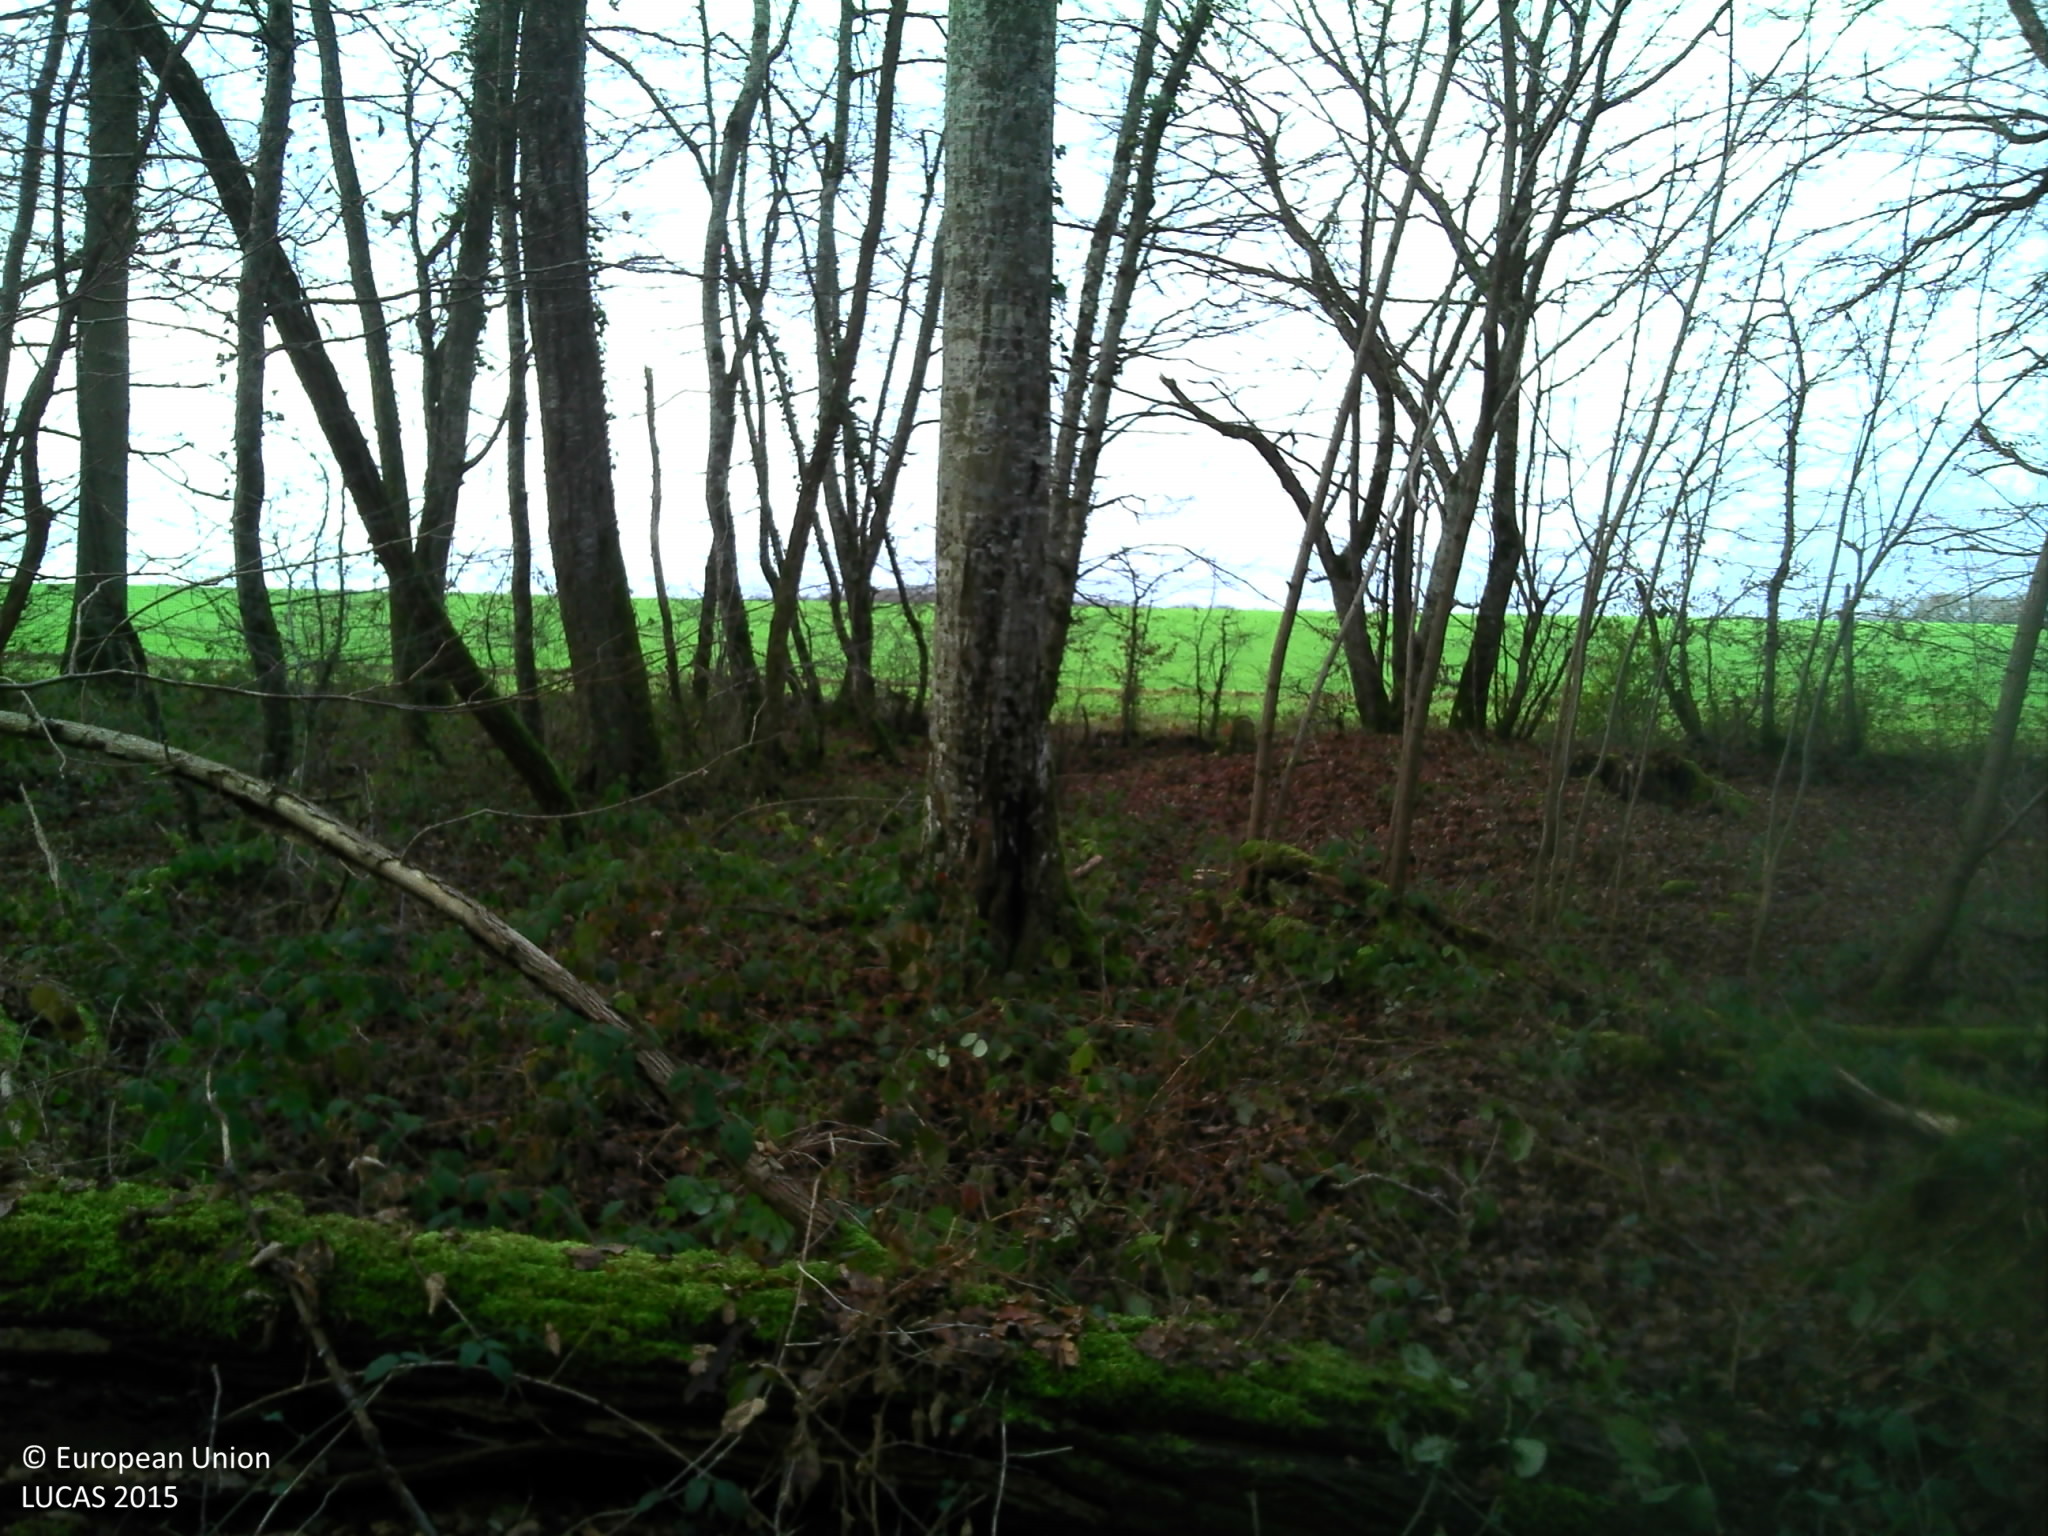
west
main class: Woodland
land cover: Broadleaved woodland
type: mesophytic deciduous forest
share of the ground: > 75 %
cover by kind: broadleaved forest trees 100 %
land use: Forestry
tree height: > 5 m
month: December
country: FR
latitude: 47.2621
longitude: 3.6140
